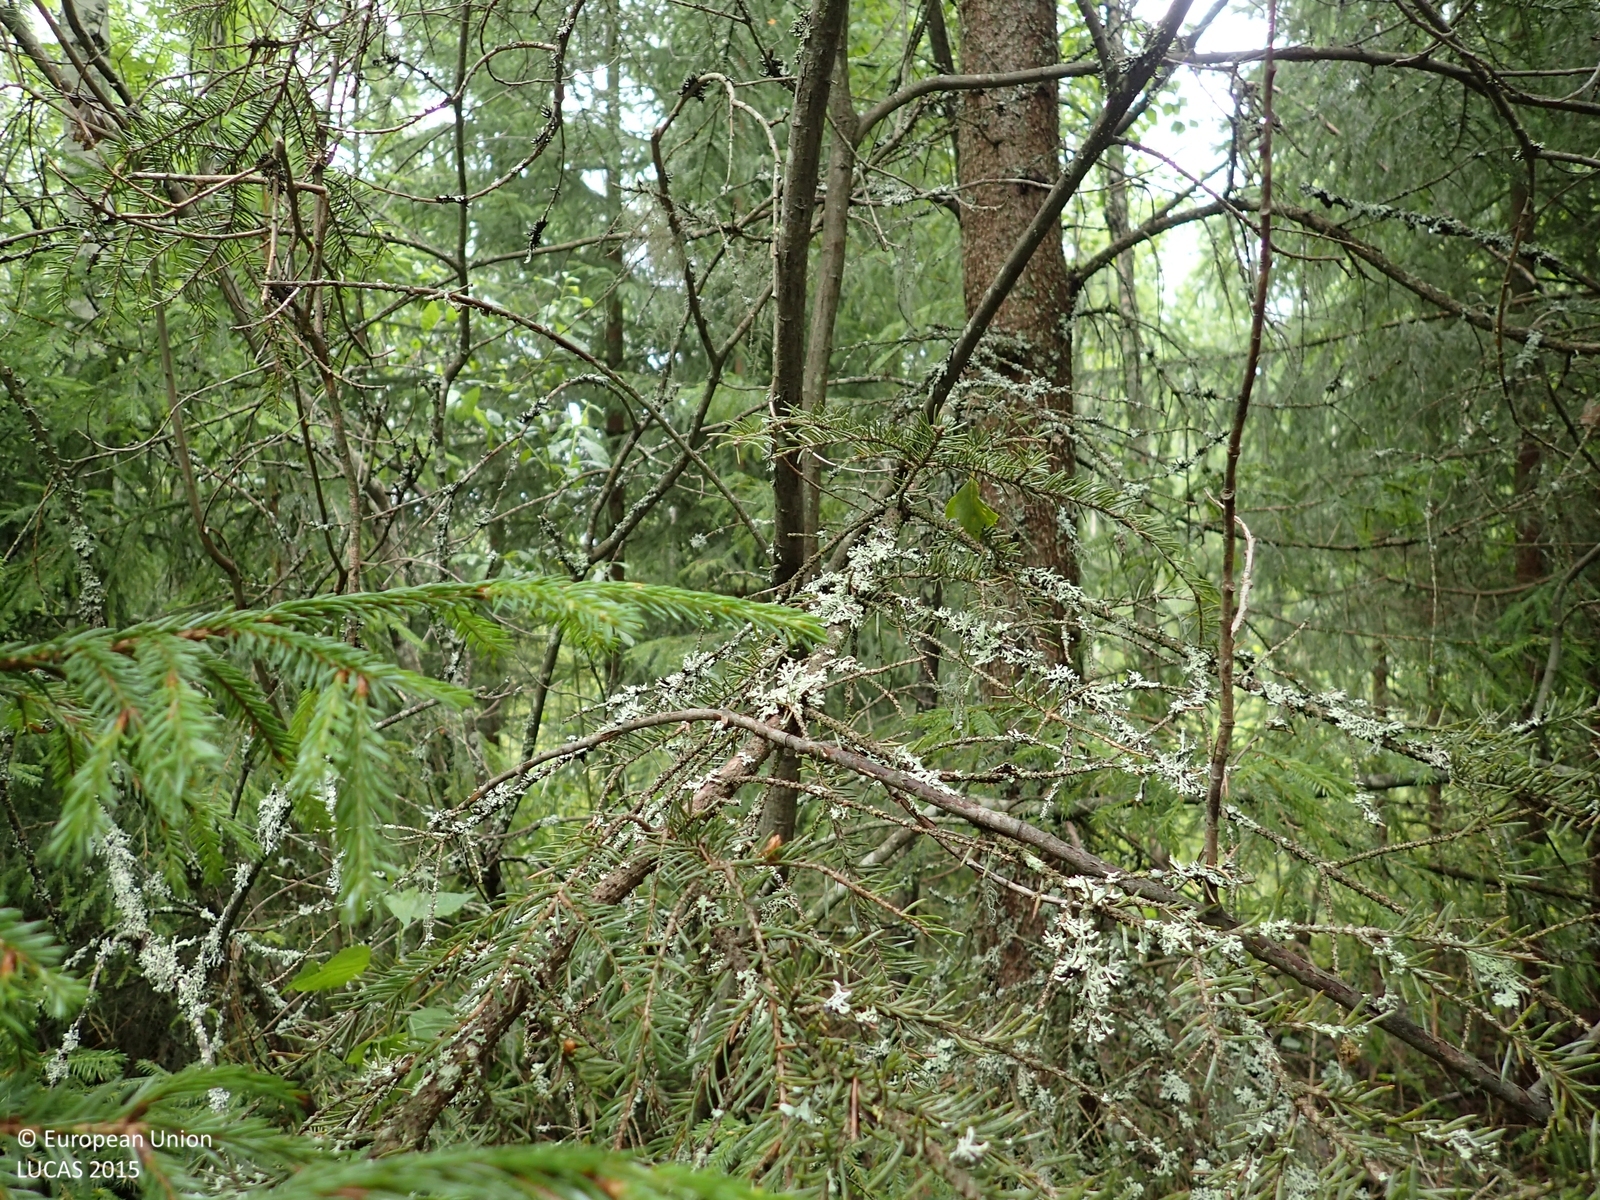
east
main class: Woodland
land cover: Spruce dominated mixed woodland
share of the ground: > 75 %
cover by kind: broadleaved forest trees 60 %, coniferous forest trees 20 %, shrubs 10 %, herbaceous plants 5 %, lichens and mosses 5 %
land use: Forestry
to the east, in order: Spruce dominated mixed woodland; Broadleaved woodland; Ditches and canals; Abandoned hedges; Oats; Shruby margins; Ditches and canals; Shruby margins; Oats; Shruby margins; Ditches and canals; Pine dominated mixed woodland
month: July
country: FI
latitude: 62.9387
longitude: 22.8438
